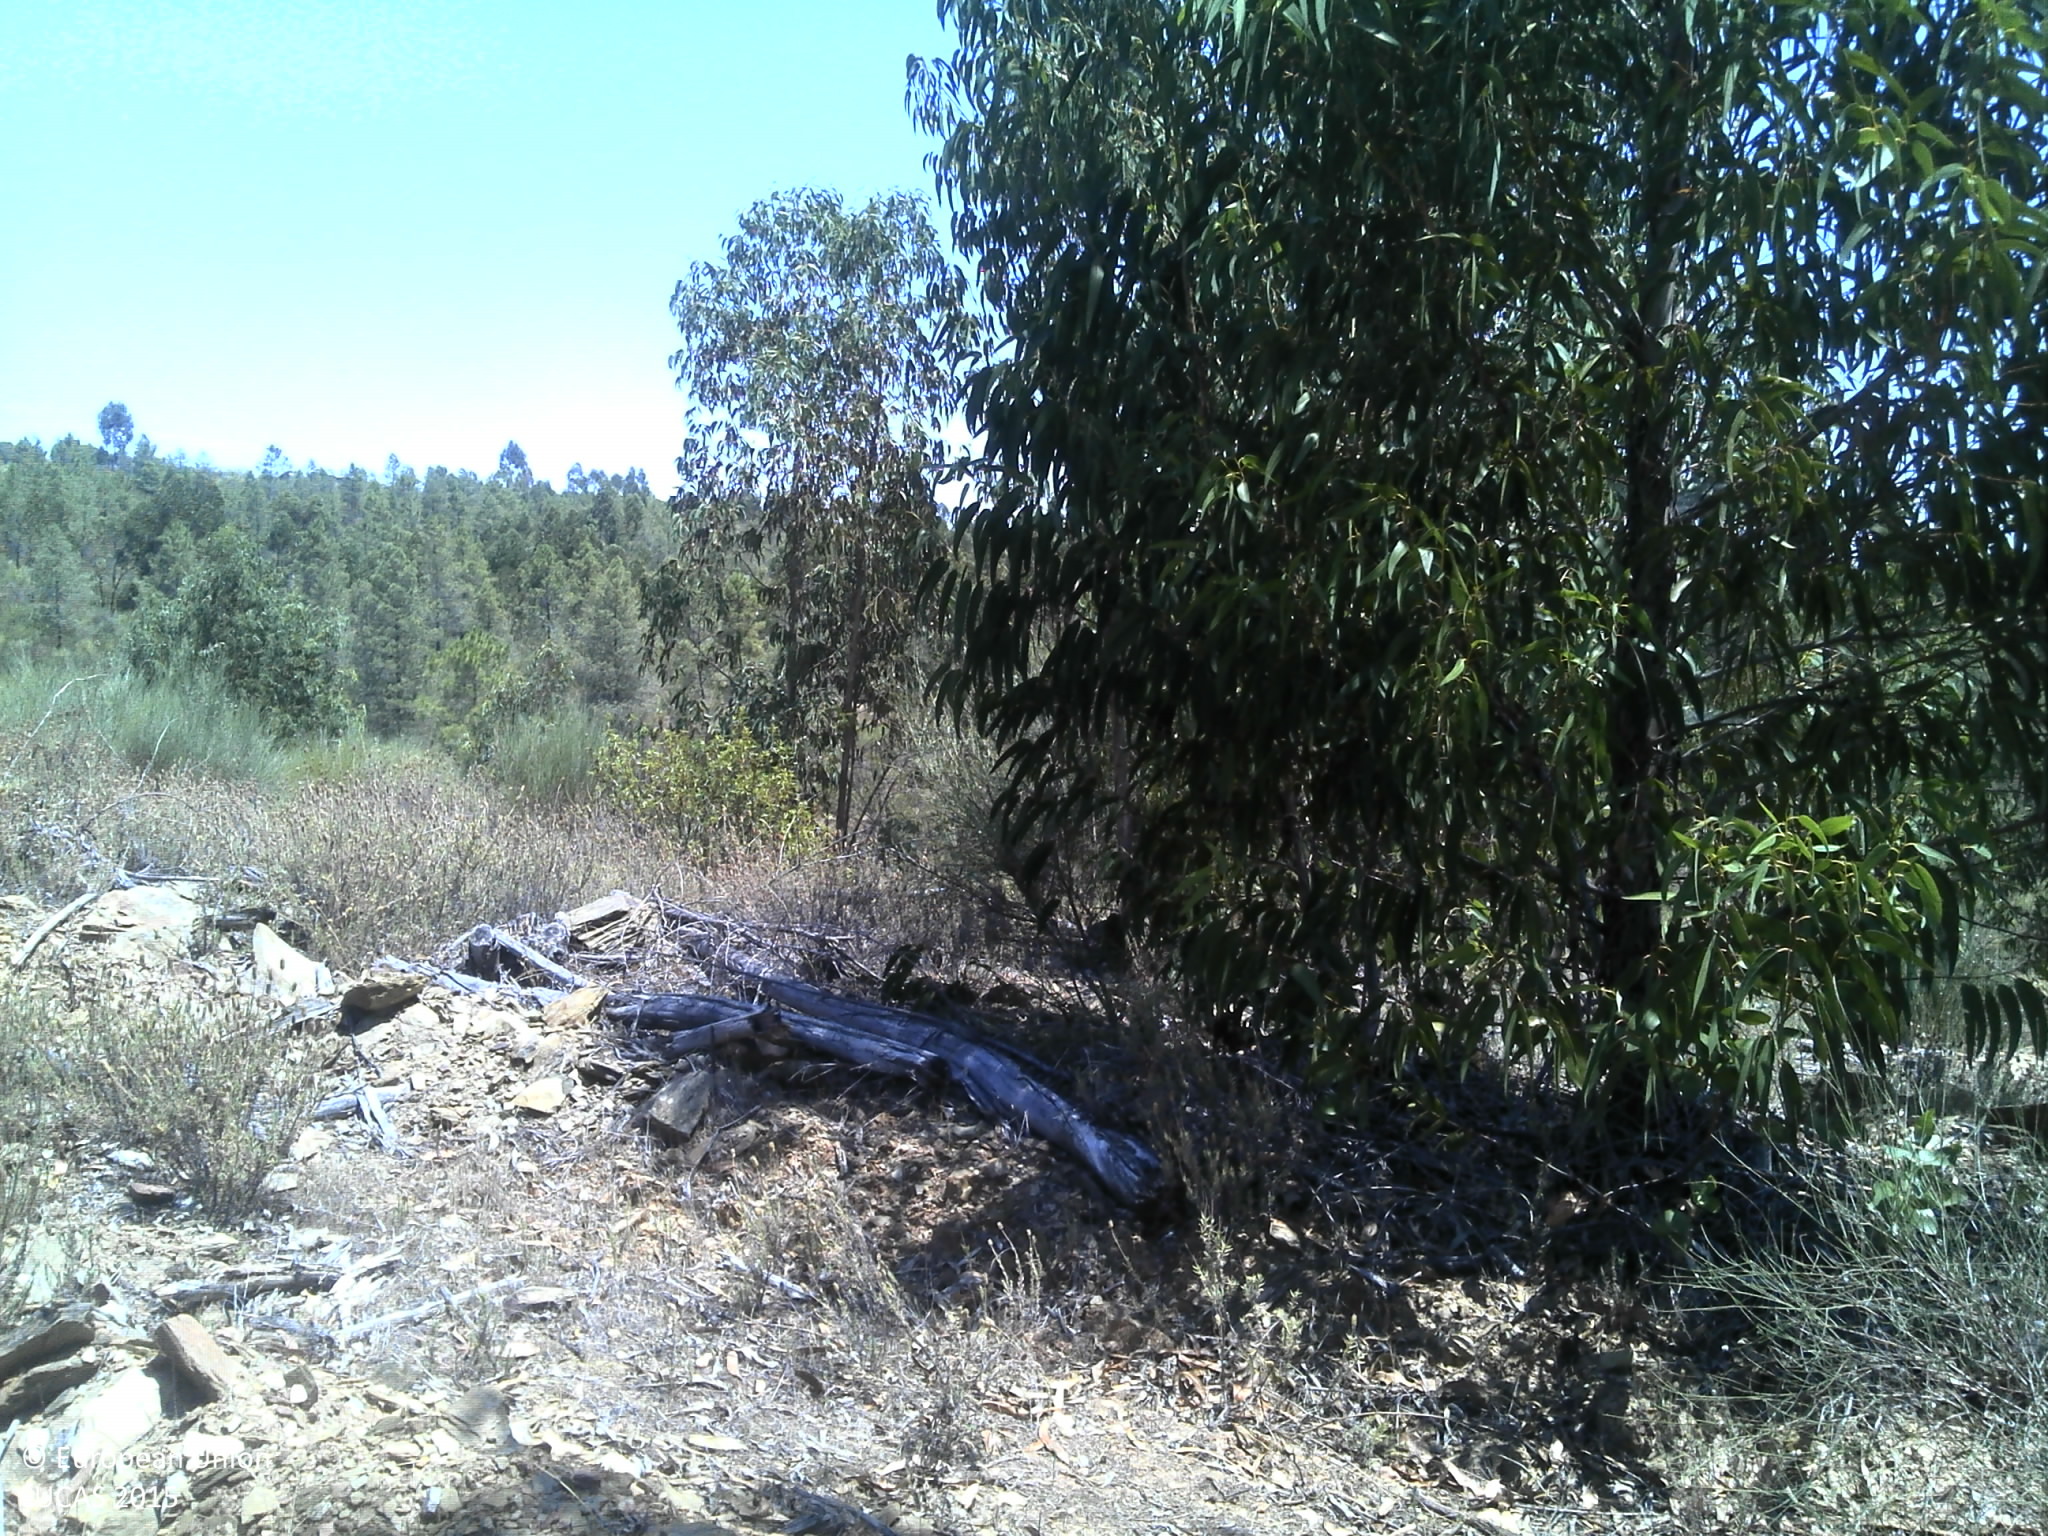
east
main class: Woodland
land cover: Broadleaved woodland
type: exotic forest
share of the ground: 25 - 50 %
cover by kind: broadleaved forest trees 50 %, unconsolidated bare surface 35 %, shrubs 15 %
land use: Forestry
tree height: > 5 m
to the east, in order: Broadleaved woodland; Tracks; Shruby margins; Rivers and streams; Shruby margins; Pine dominated coniferous woodland; Shrubland without tree cover; Pine dominated coniferous woodland
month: June
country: PT
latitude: 39.7669
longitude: -7.0017
